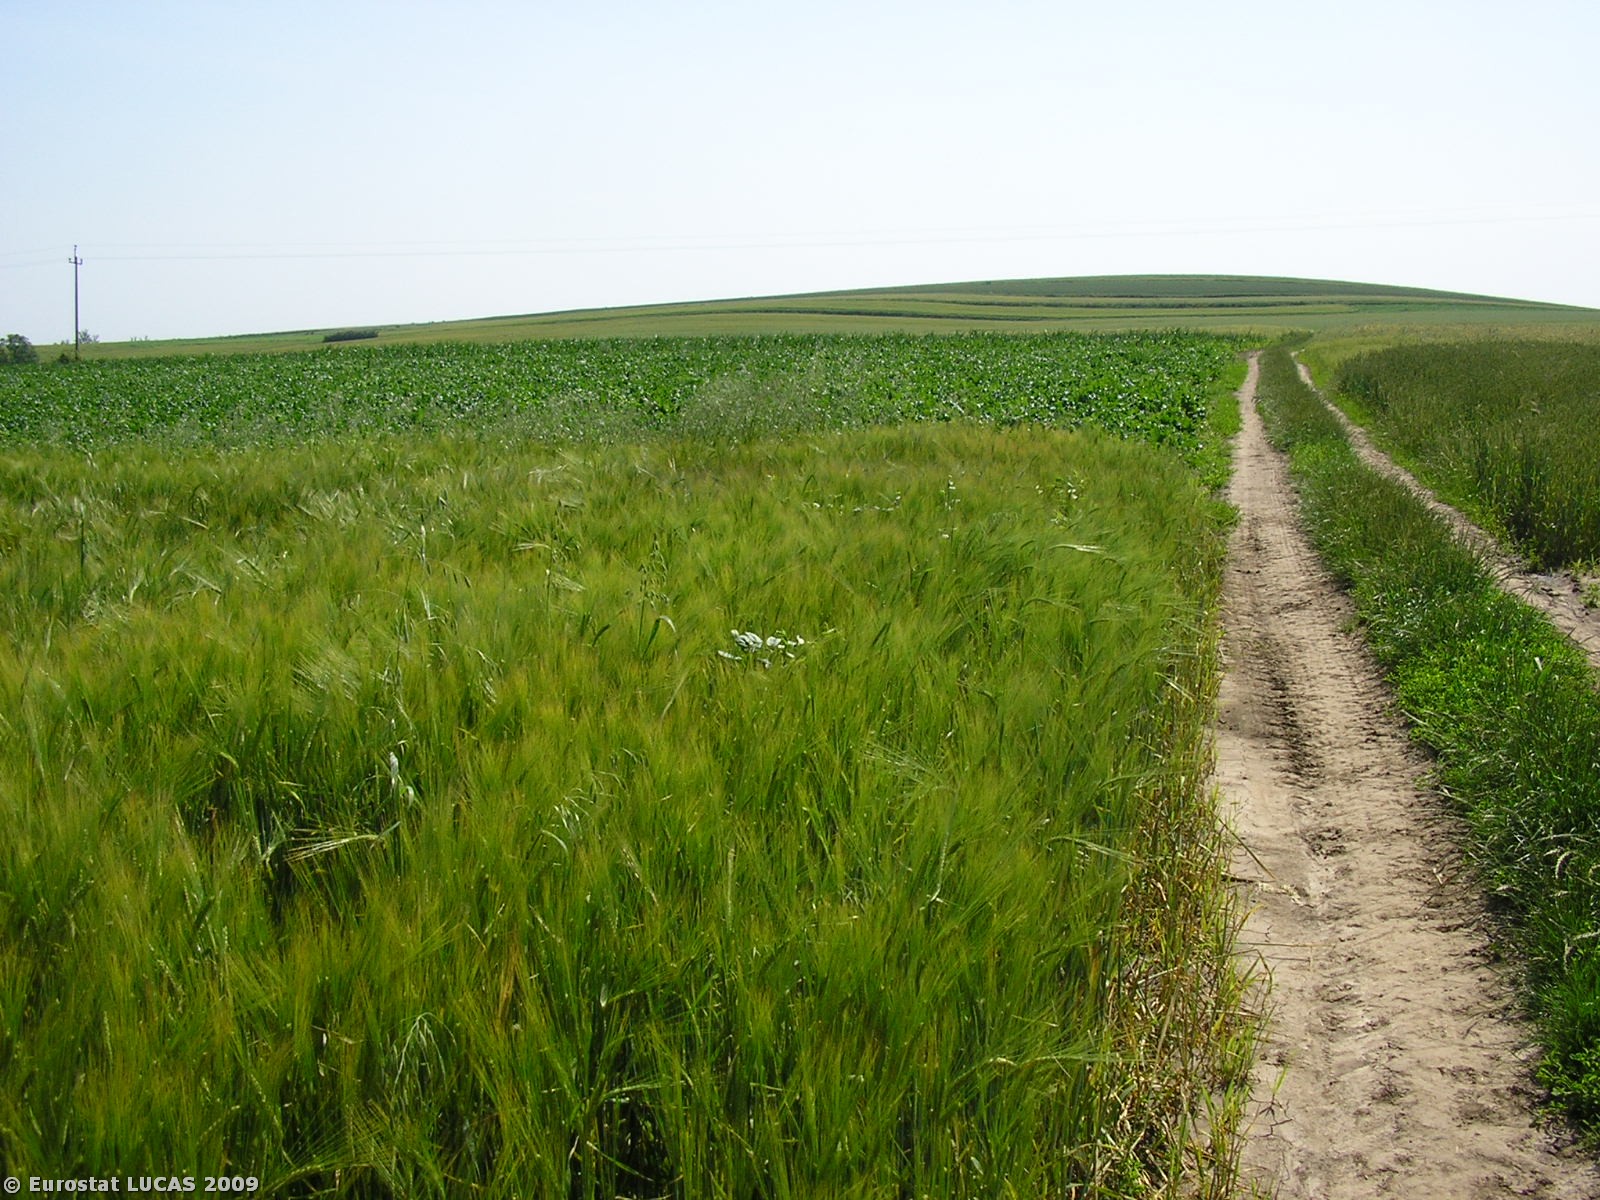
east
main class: Cropland
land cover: Barley
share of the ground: > 75 %
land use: Agriculture (excluding fallow land and kitchen gardens)
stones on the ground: < 10 %
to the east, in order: Barley; Sugar beet; Maize; Electric lines; Maize; Grass margins; Barley; Sugar beet; Potatoes; Barley; Grass margins; Paved roads, cycling and walking lanes; Grass margins; Lines of trees; Potatoes; Sugar beet; Maize; Grass margins; Triticale
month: June
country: PL
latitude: 50.3705
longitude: 20.2851
